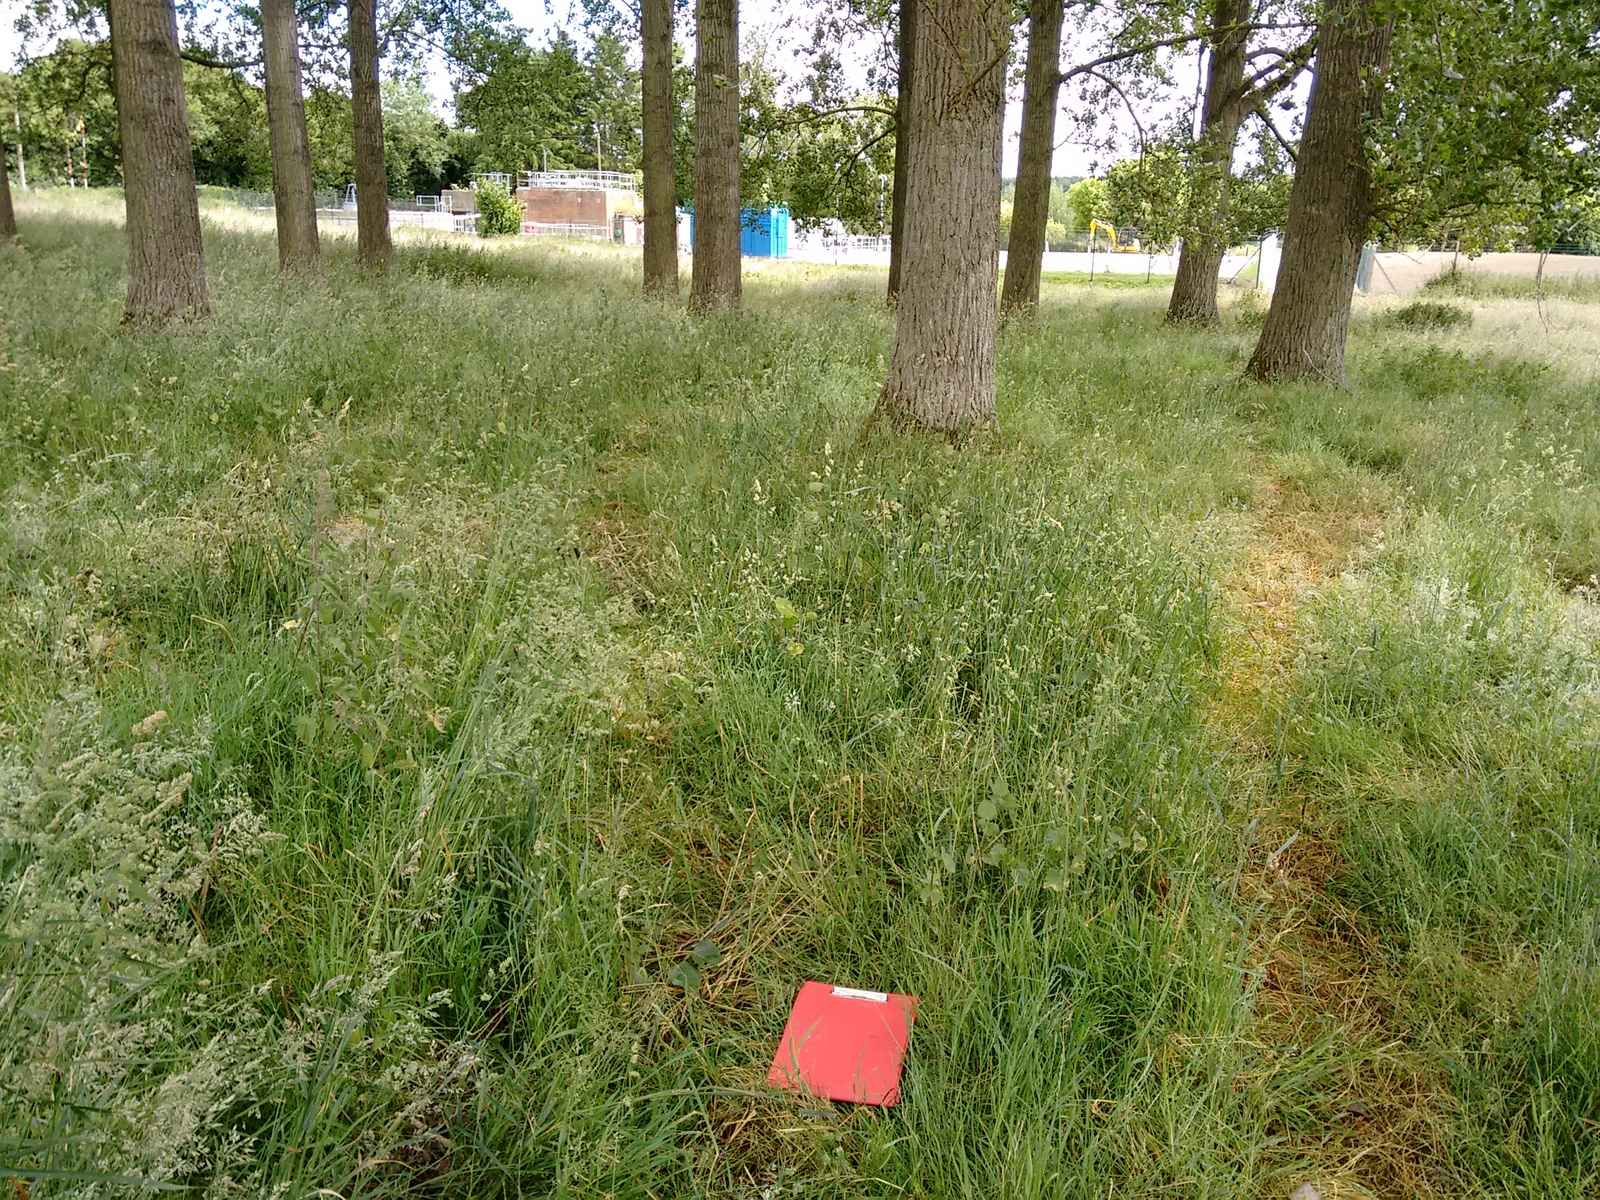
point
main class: Woodland
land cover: Broadleaved woodland
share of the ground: > 75 %
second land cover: Grassland without tree/shrub cover
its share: 10 - 25 %
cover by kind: broadleaved forest trees 80 %, herbaceous plants 20 %
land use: Waste treatment
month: June
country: GB
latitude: 51.4790
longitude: -1.2355
